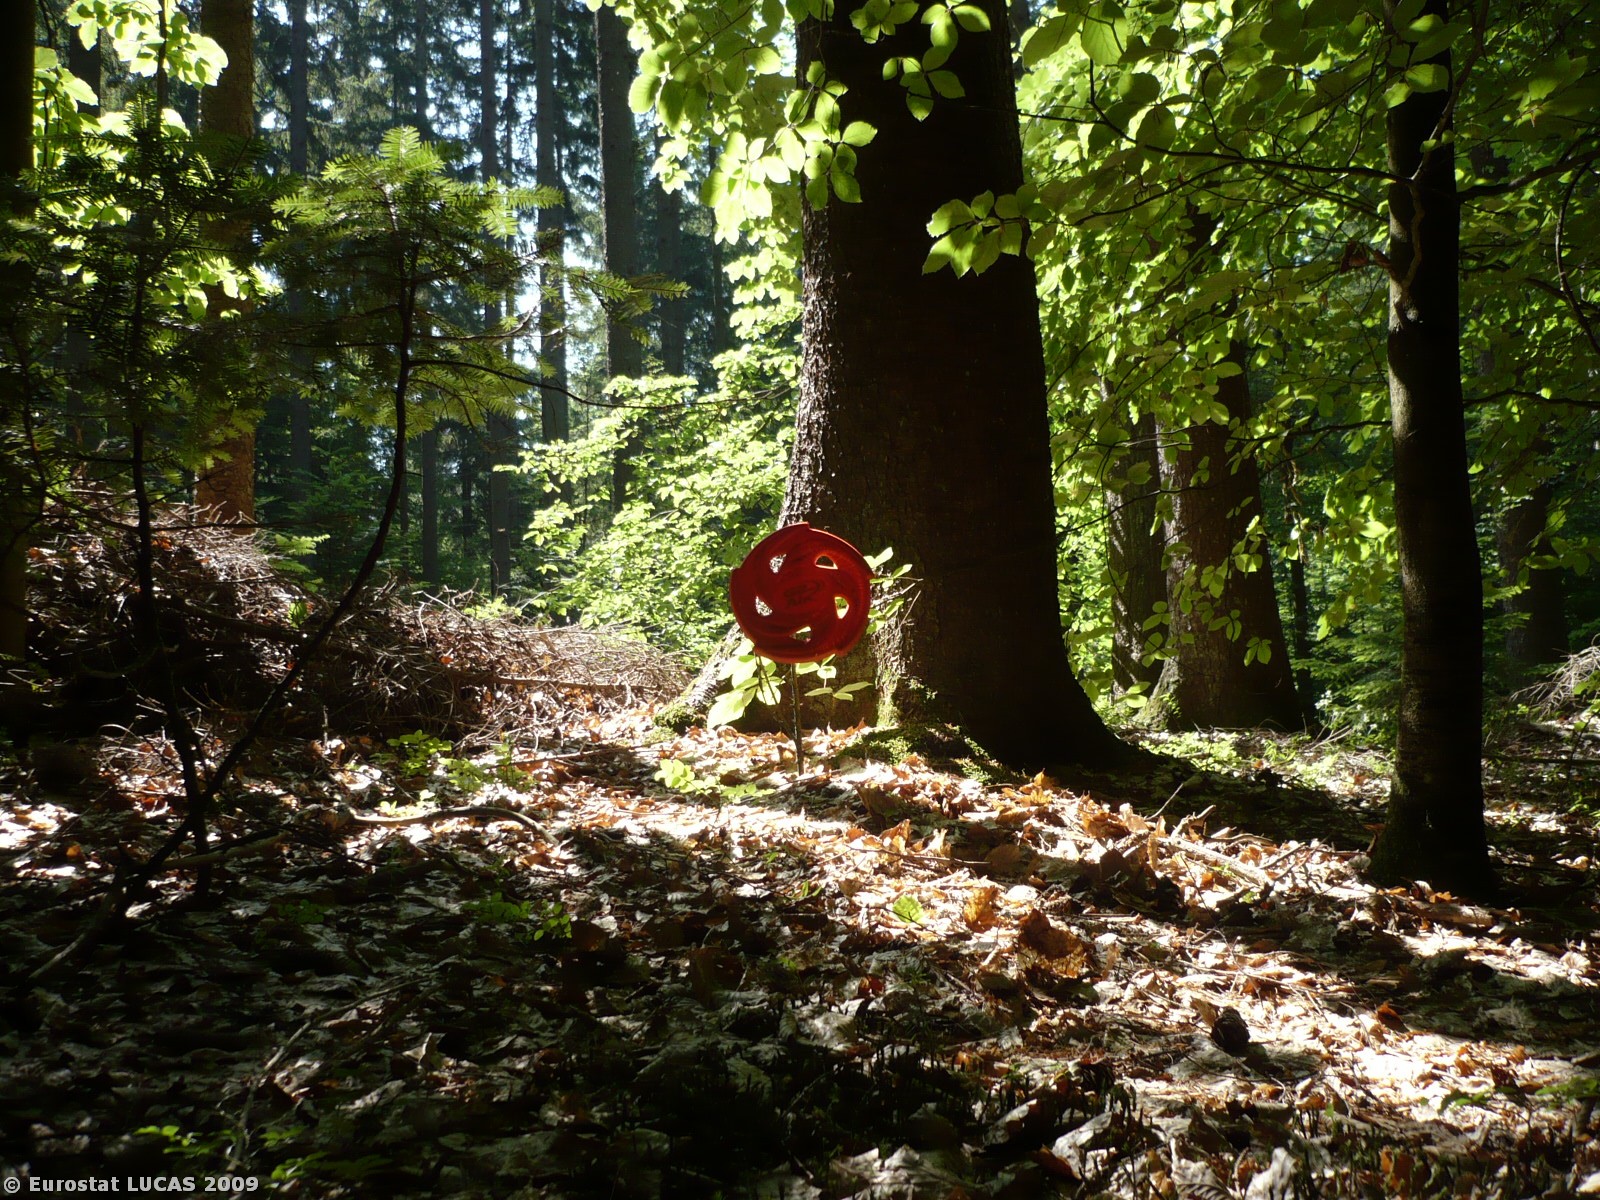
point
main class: Woodland
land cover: Mixed woodland
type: hemiboreal forest and nemoral coniferous forest and mixed broadleaved-coniferous forest
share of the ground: > 75 %
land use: Forestry
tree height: > 5 m
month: May
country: SI
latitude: 46.2852
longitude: 14.2410
